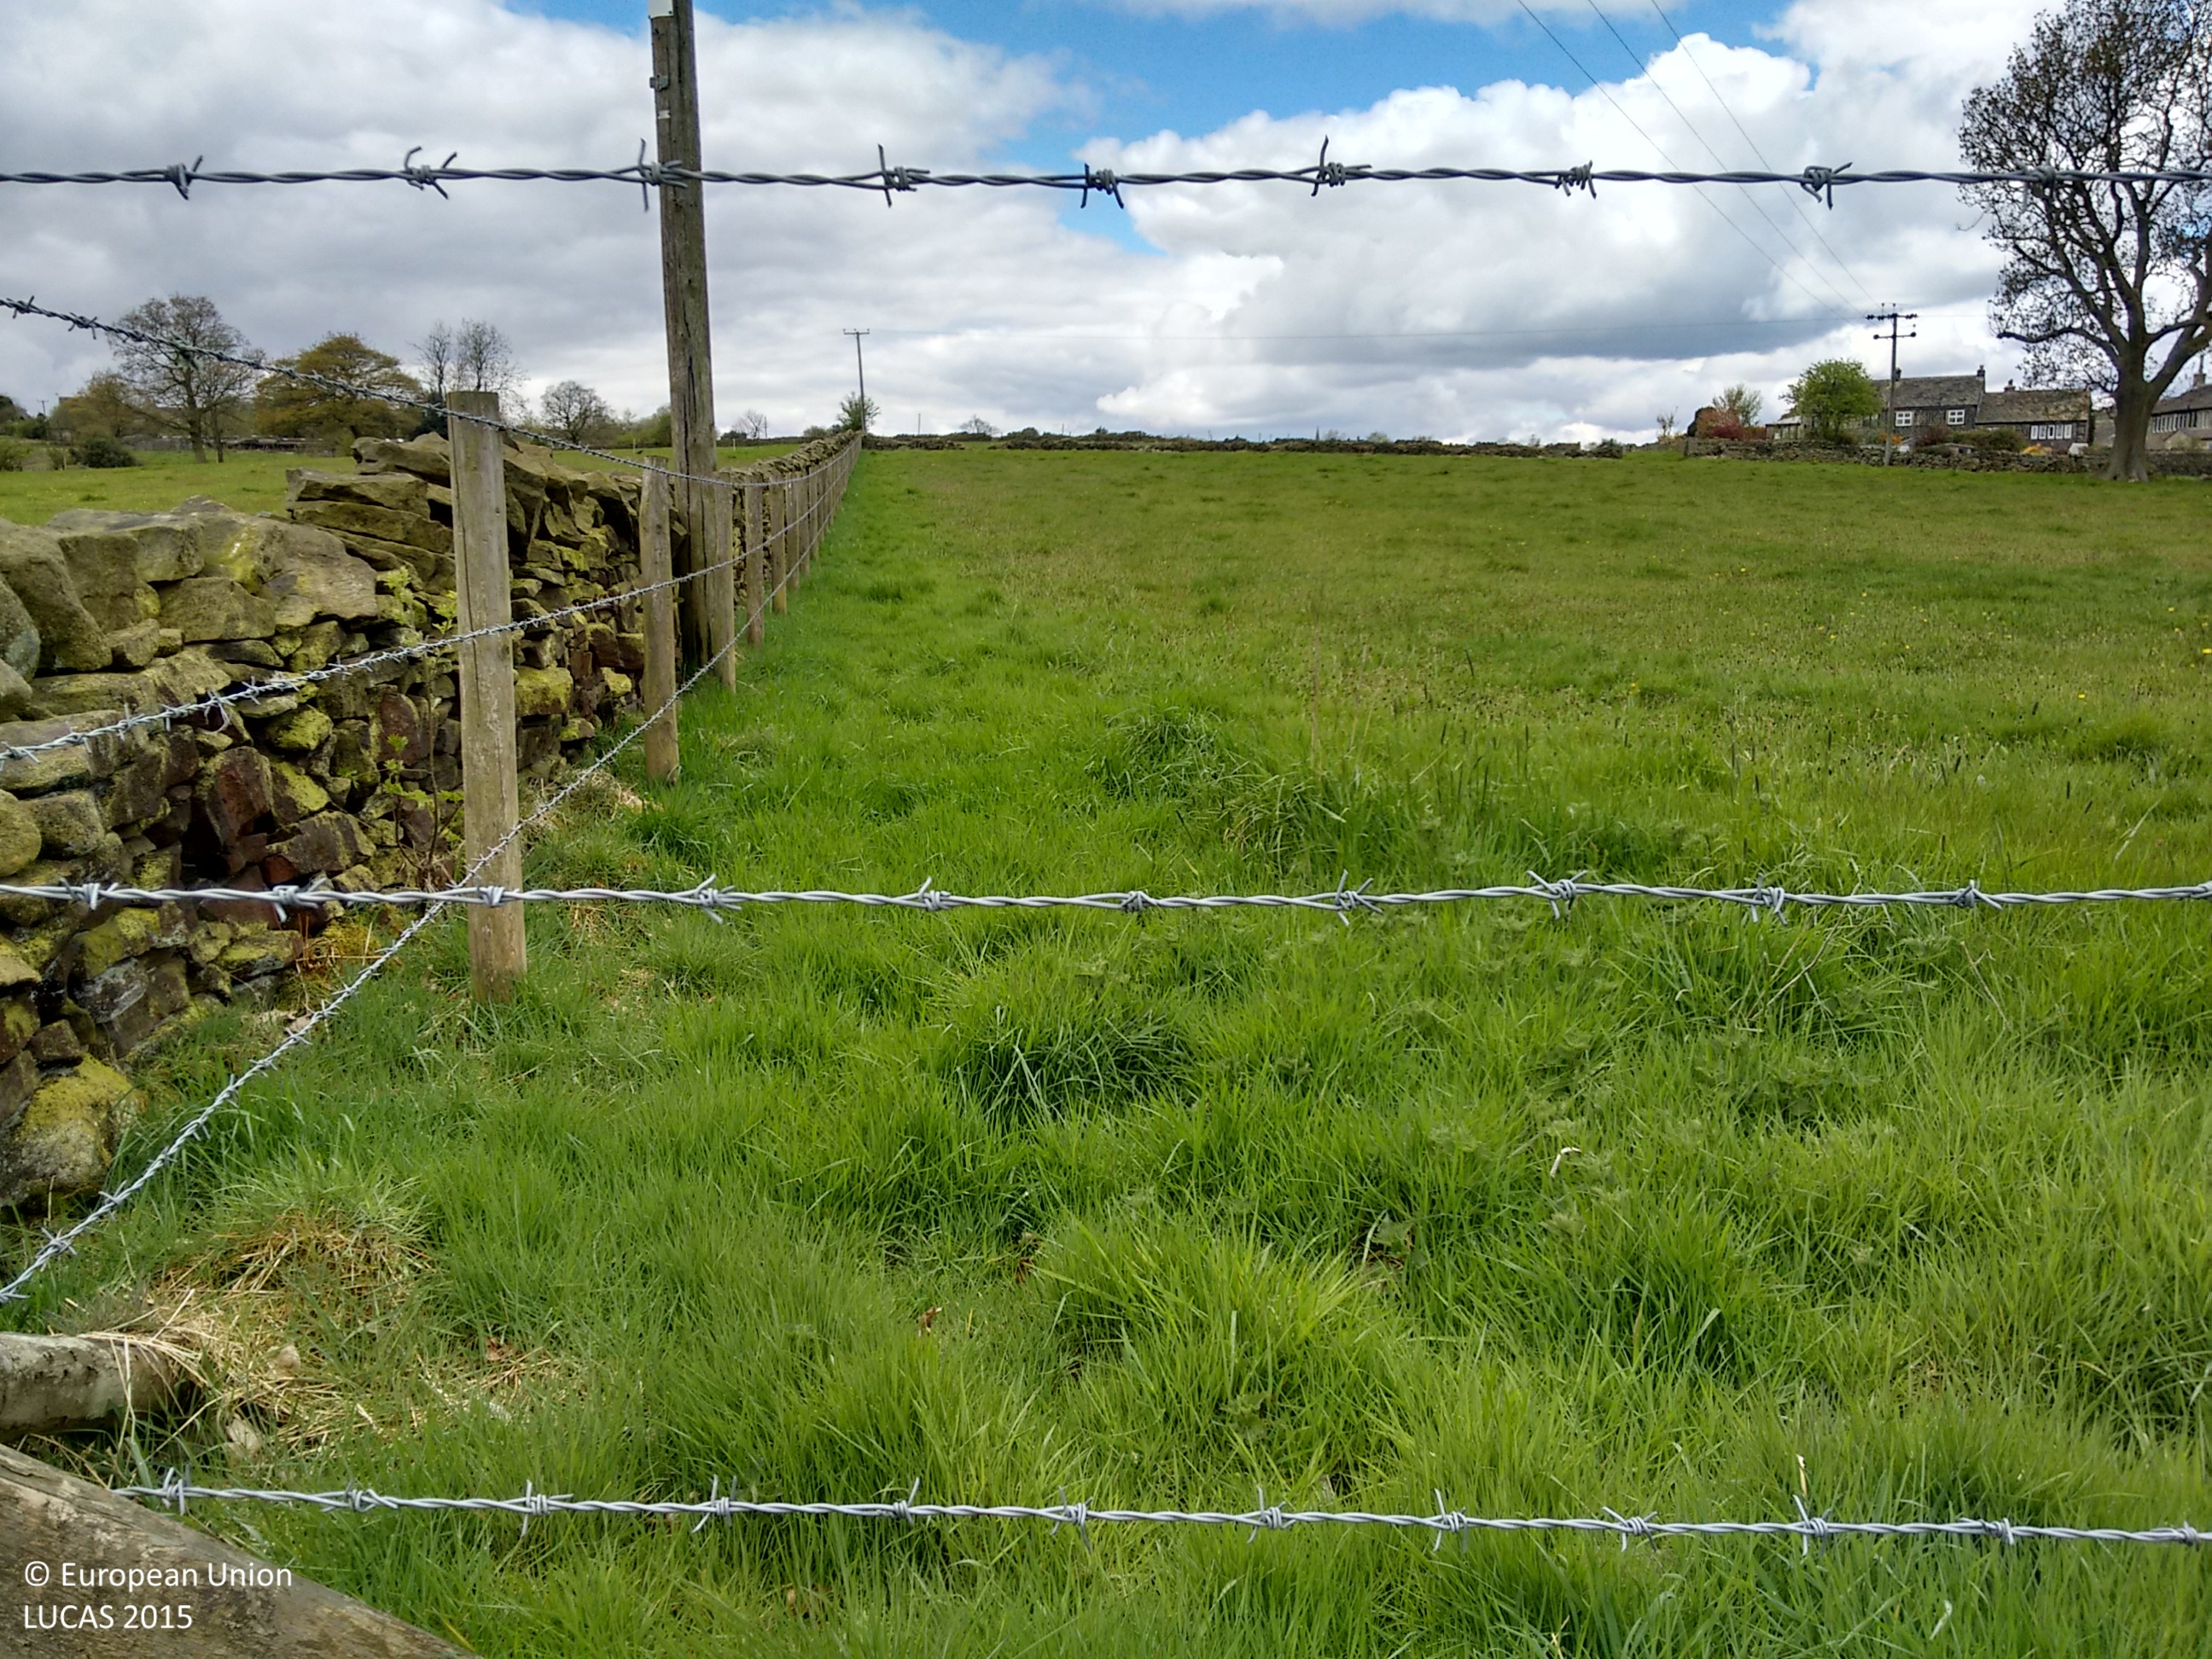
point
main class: Grassland
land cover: Grassland without tree/shrub cover
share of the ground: > 75 %
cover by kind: herbaceous plants 100 %
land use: Agriculture (excluding fallow land and kitchen gardens)
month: April
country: GB
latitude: 53.5927
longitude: -1.7321
